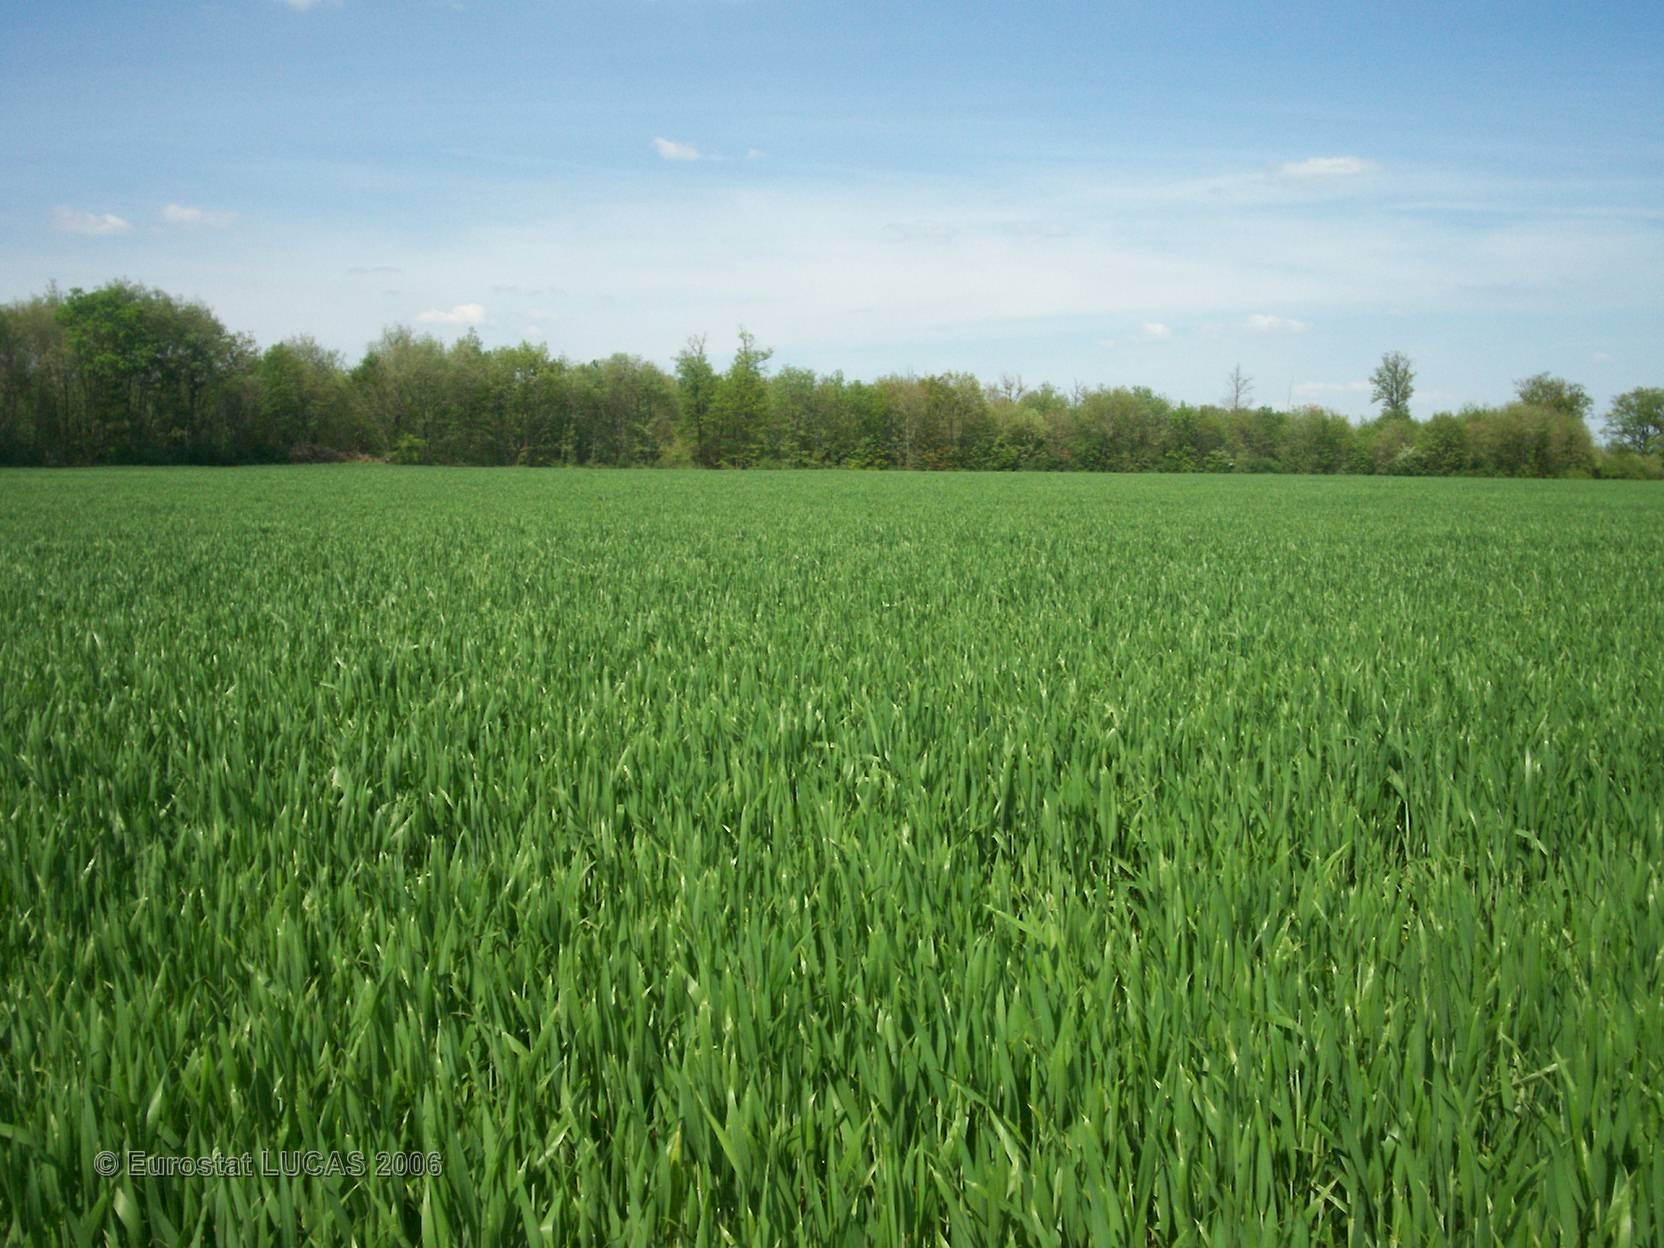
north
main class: Cropland
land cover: Common wheat
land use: Agriculture (excluding fallow land and kitchen gardens)
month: May
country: FR
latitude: 46.5061
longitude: 0.4823
